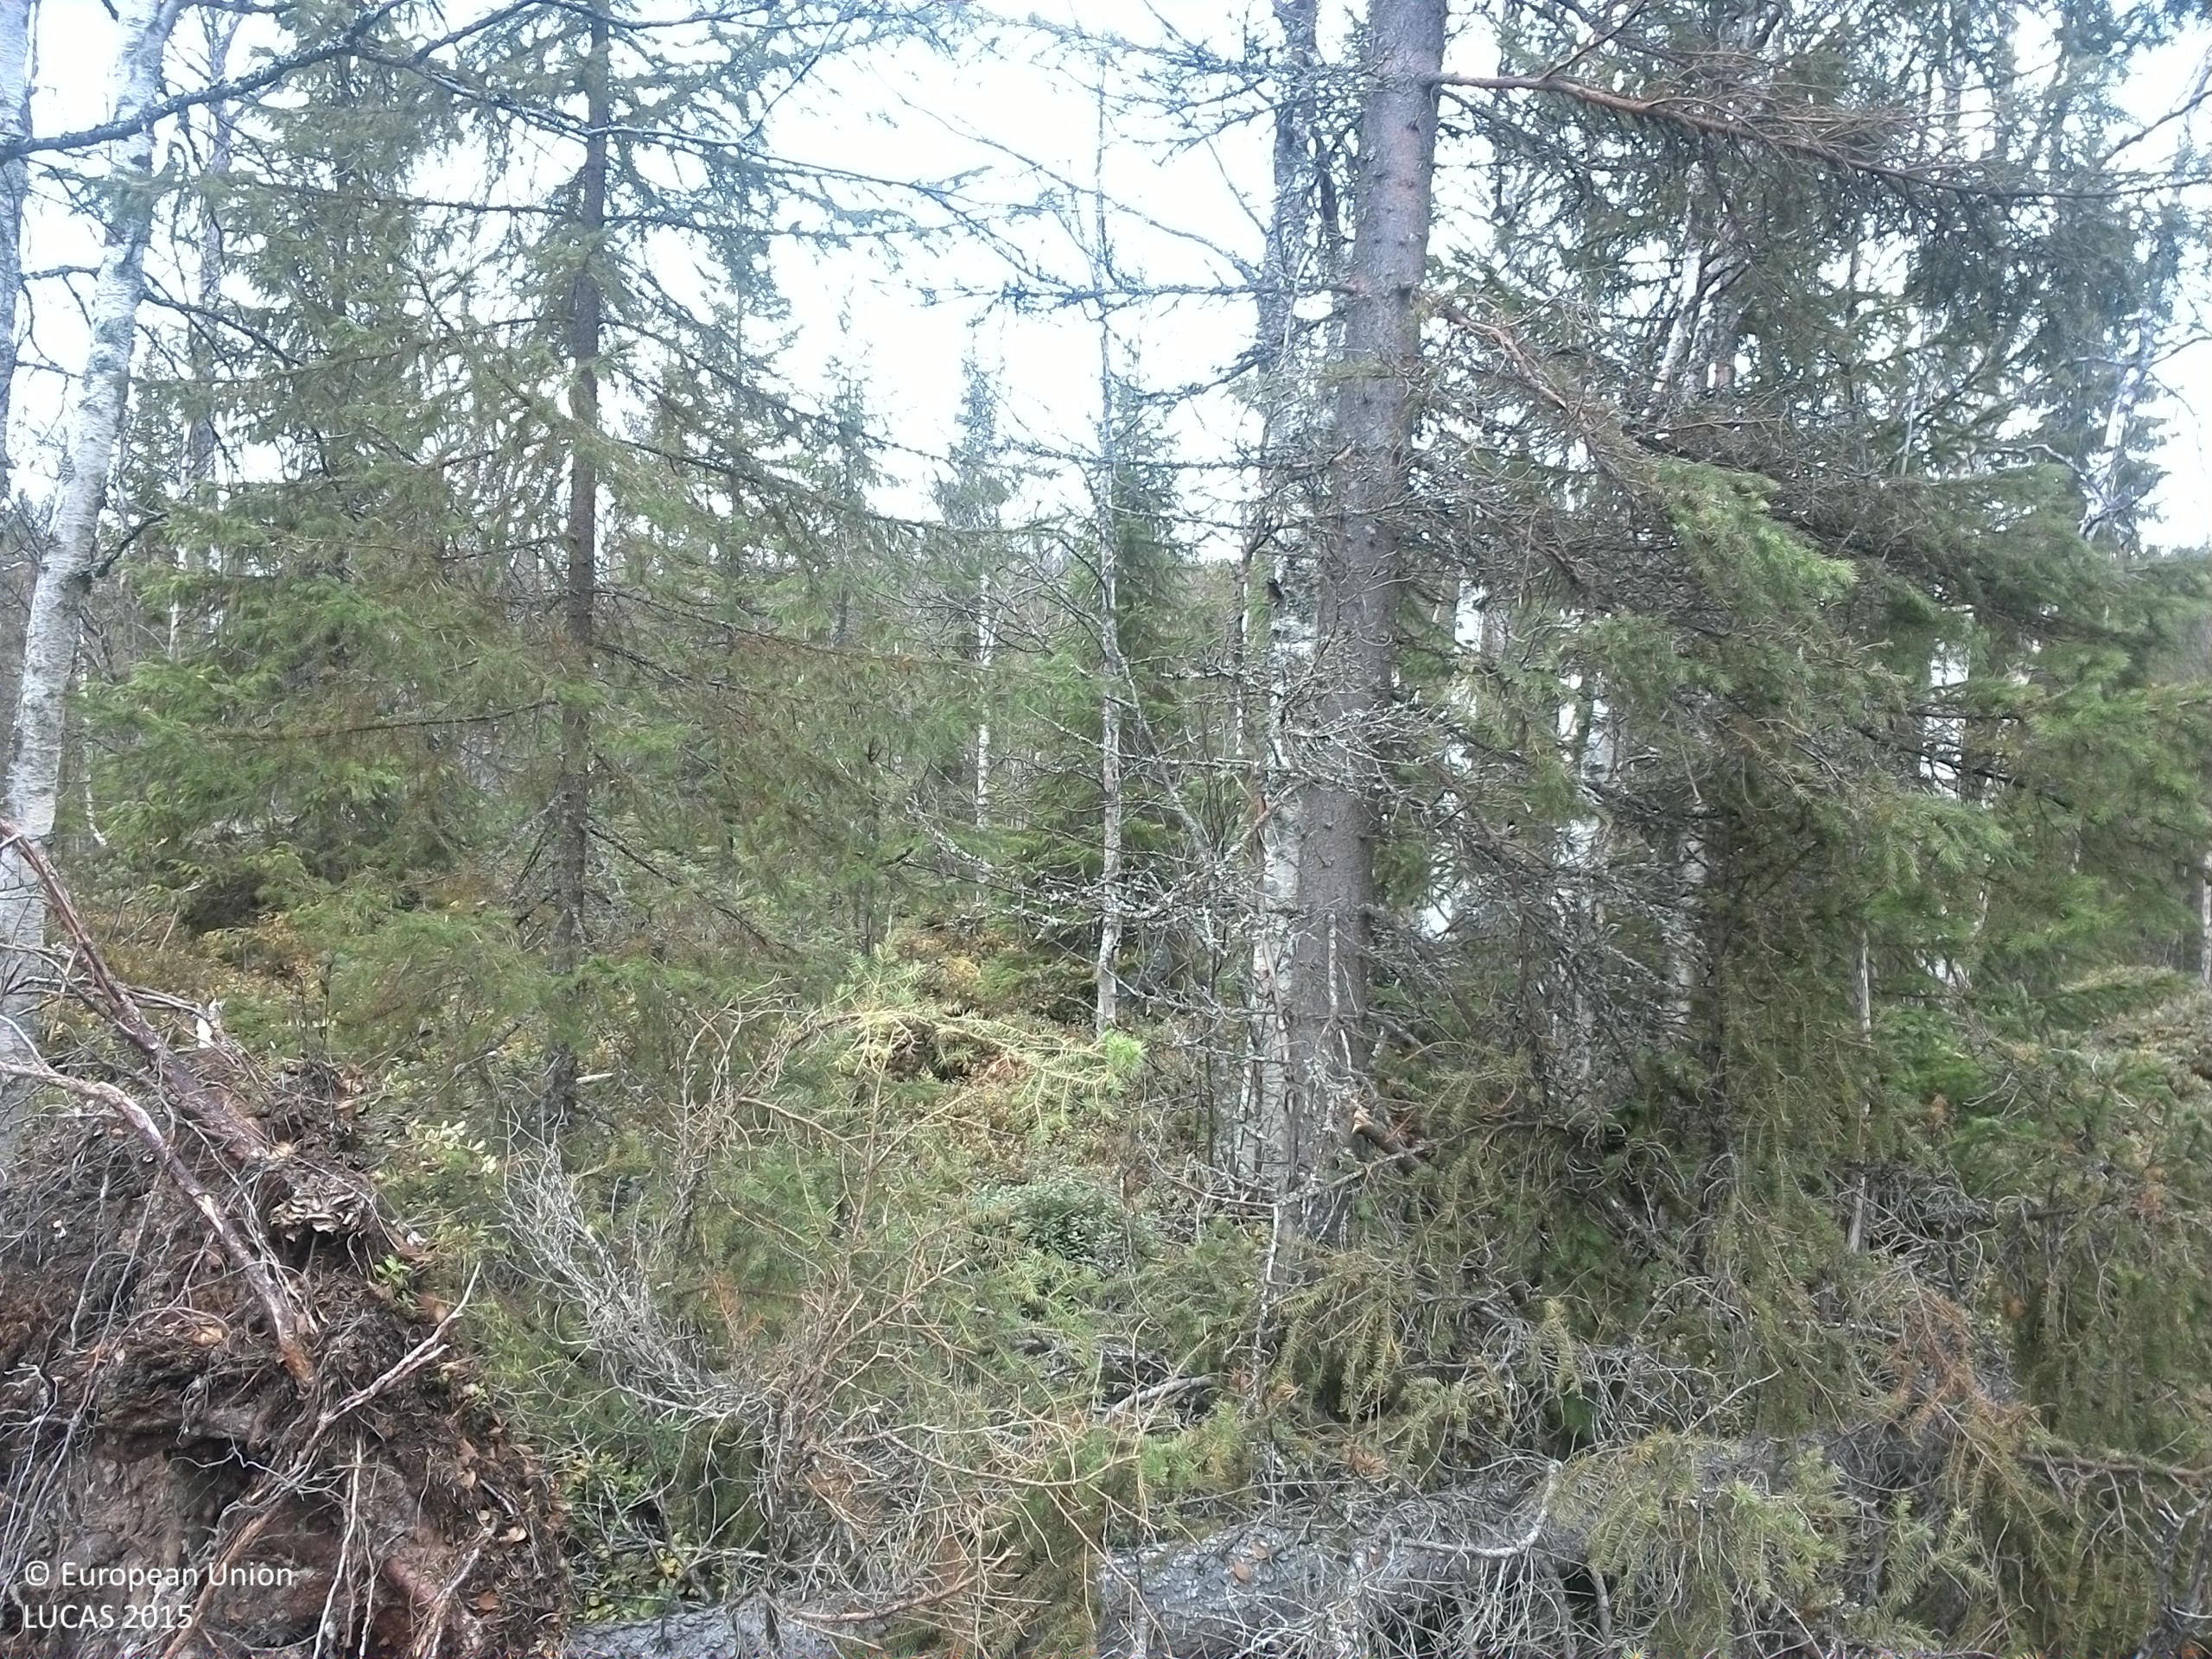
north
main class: Woodland
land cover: Spruce dominated mixed woodland
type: boreal forest
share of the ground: 25 - 50 %
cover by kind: shrubs 50 %, coniferous forest trees 20 %, broadleaved forest trees 20 %, lichens and mosses 10 %
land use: Forestry
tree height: > 5 m
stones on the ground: 25 - 50 %
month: October
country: SE
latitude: 64.4169
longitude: 14.7675
